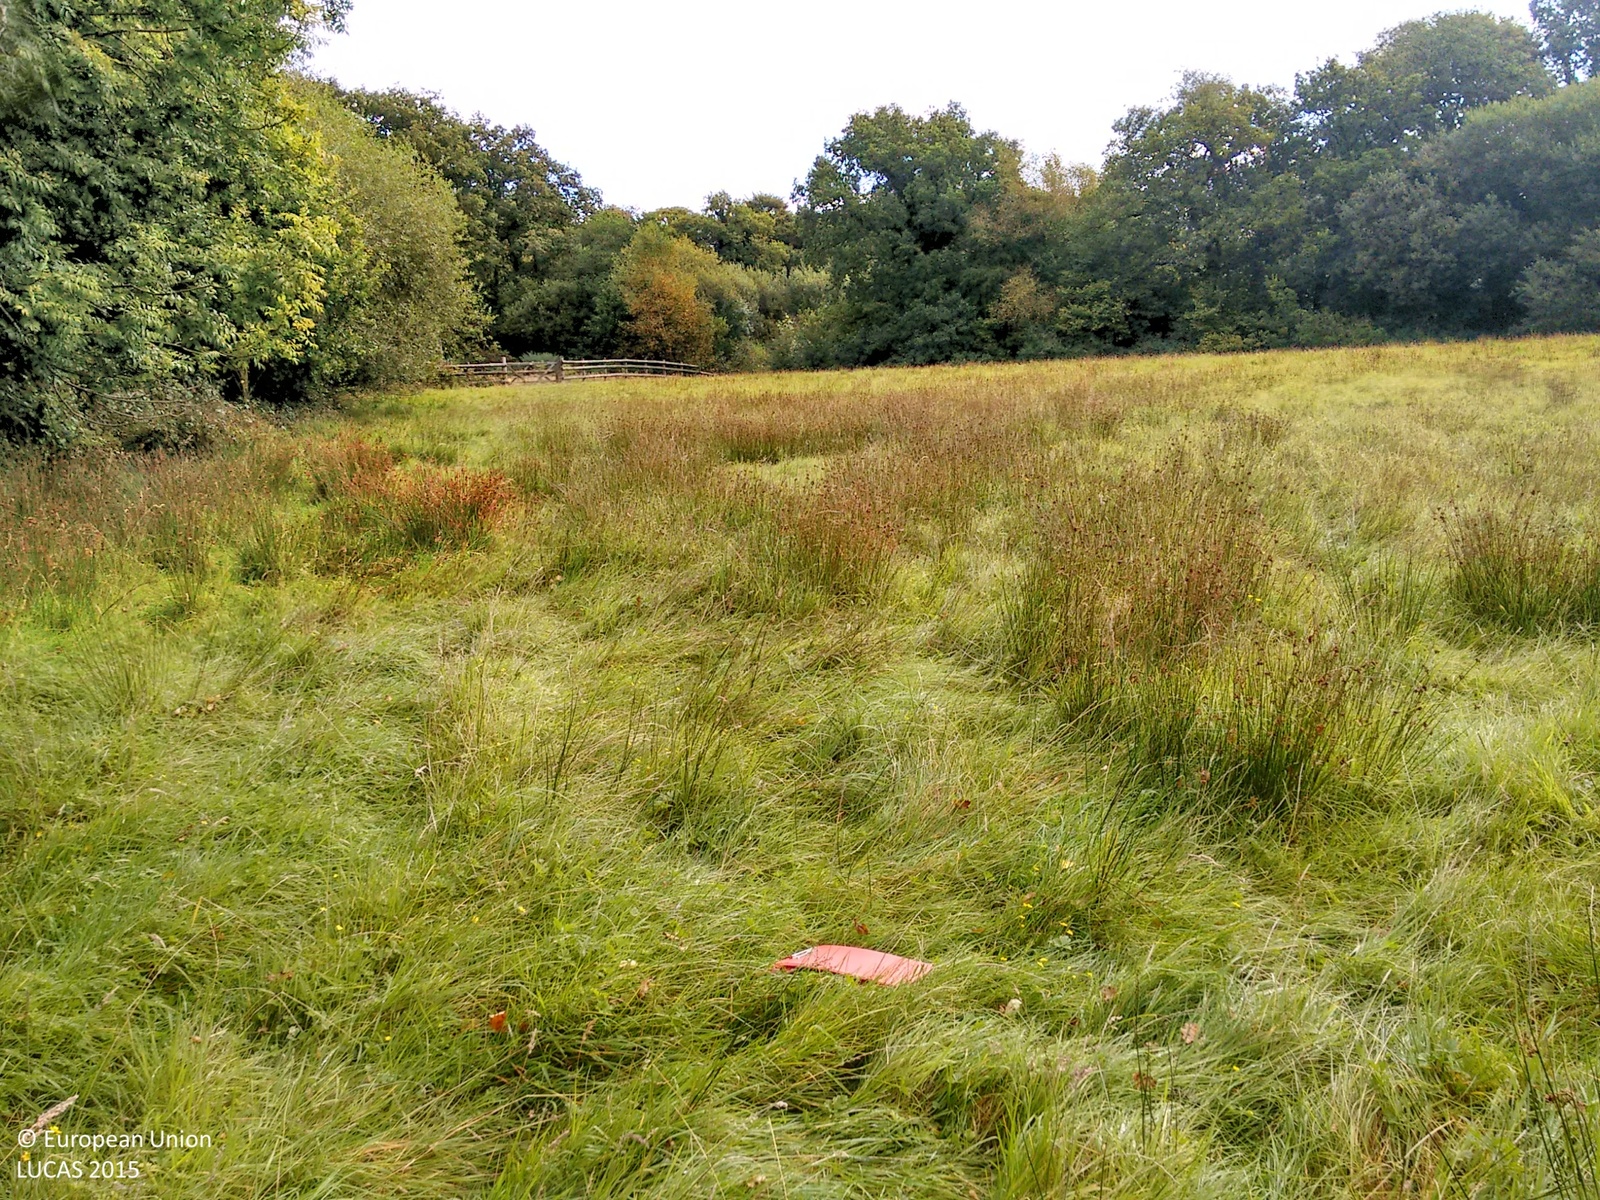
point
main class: Grassland
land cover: Grassland without tree/shrub cover
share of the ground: > 75 %
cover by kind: herbaceous plants 100 %
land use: Agriculture (excluding fallow land and kitchen gardens)
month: September
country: GB
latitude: 50.8314
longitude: -4.1390
